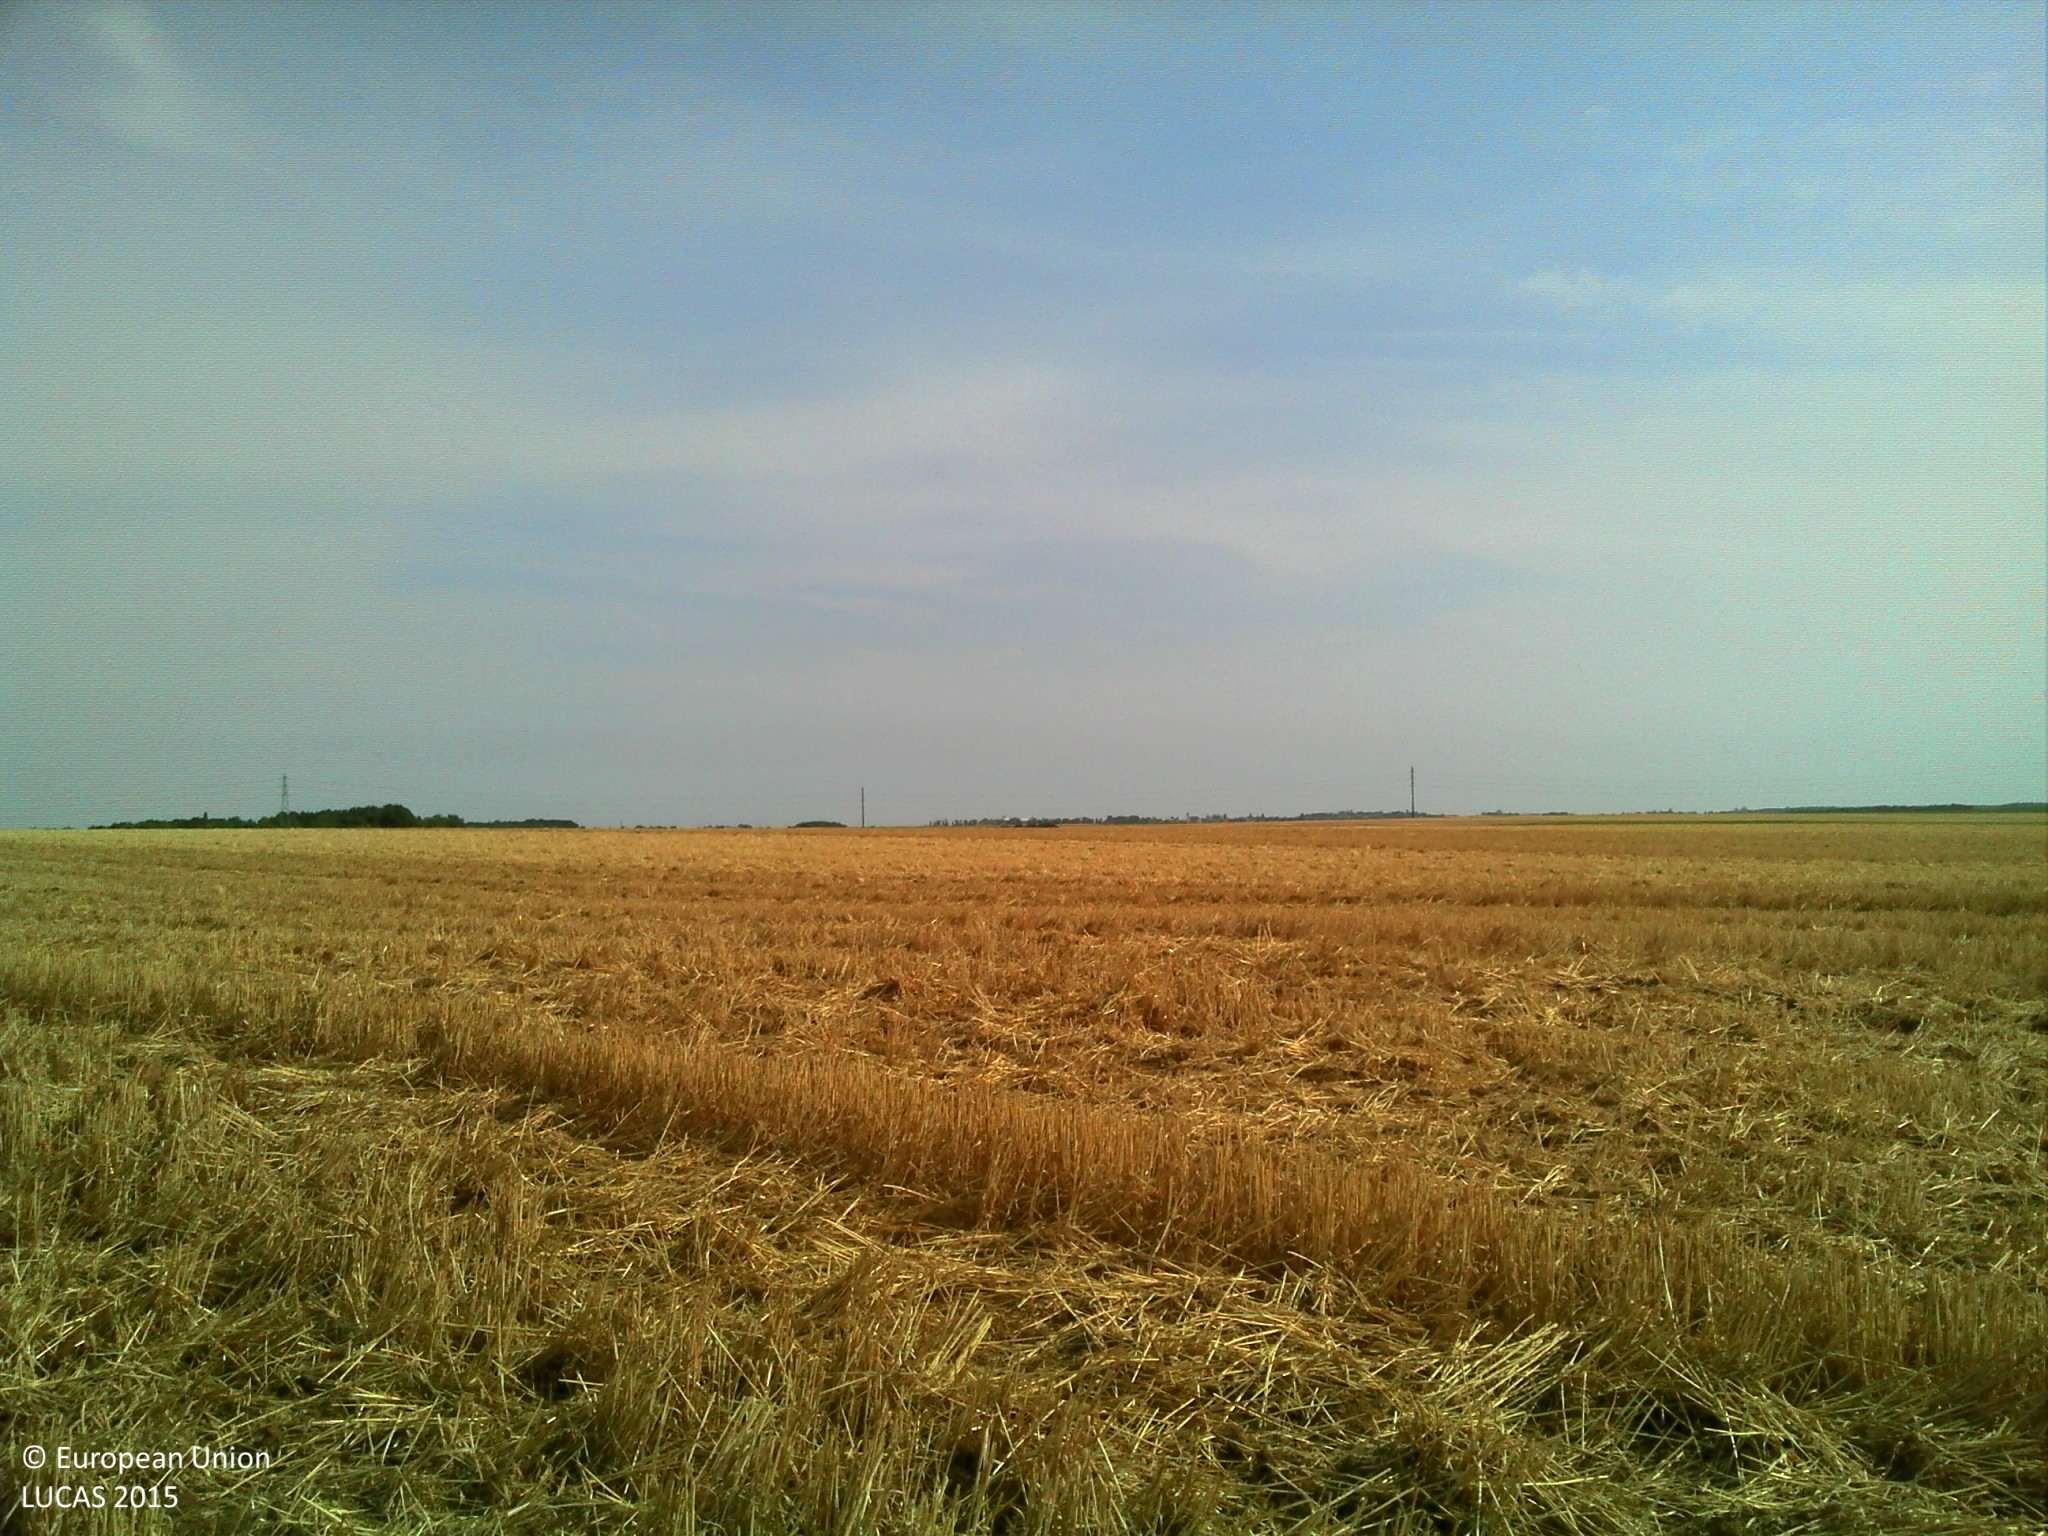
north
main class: Cropland
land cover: Common wheat
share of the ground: 10 - 25 %
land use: Agriculture (excluding fallow land and kitchen gardens)
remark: Harvested field
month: August
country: FR
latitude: 48.2777
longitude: 2.5384
